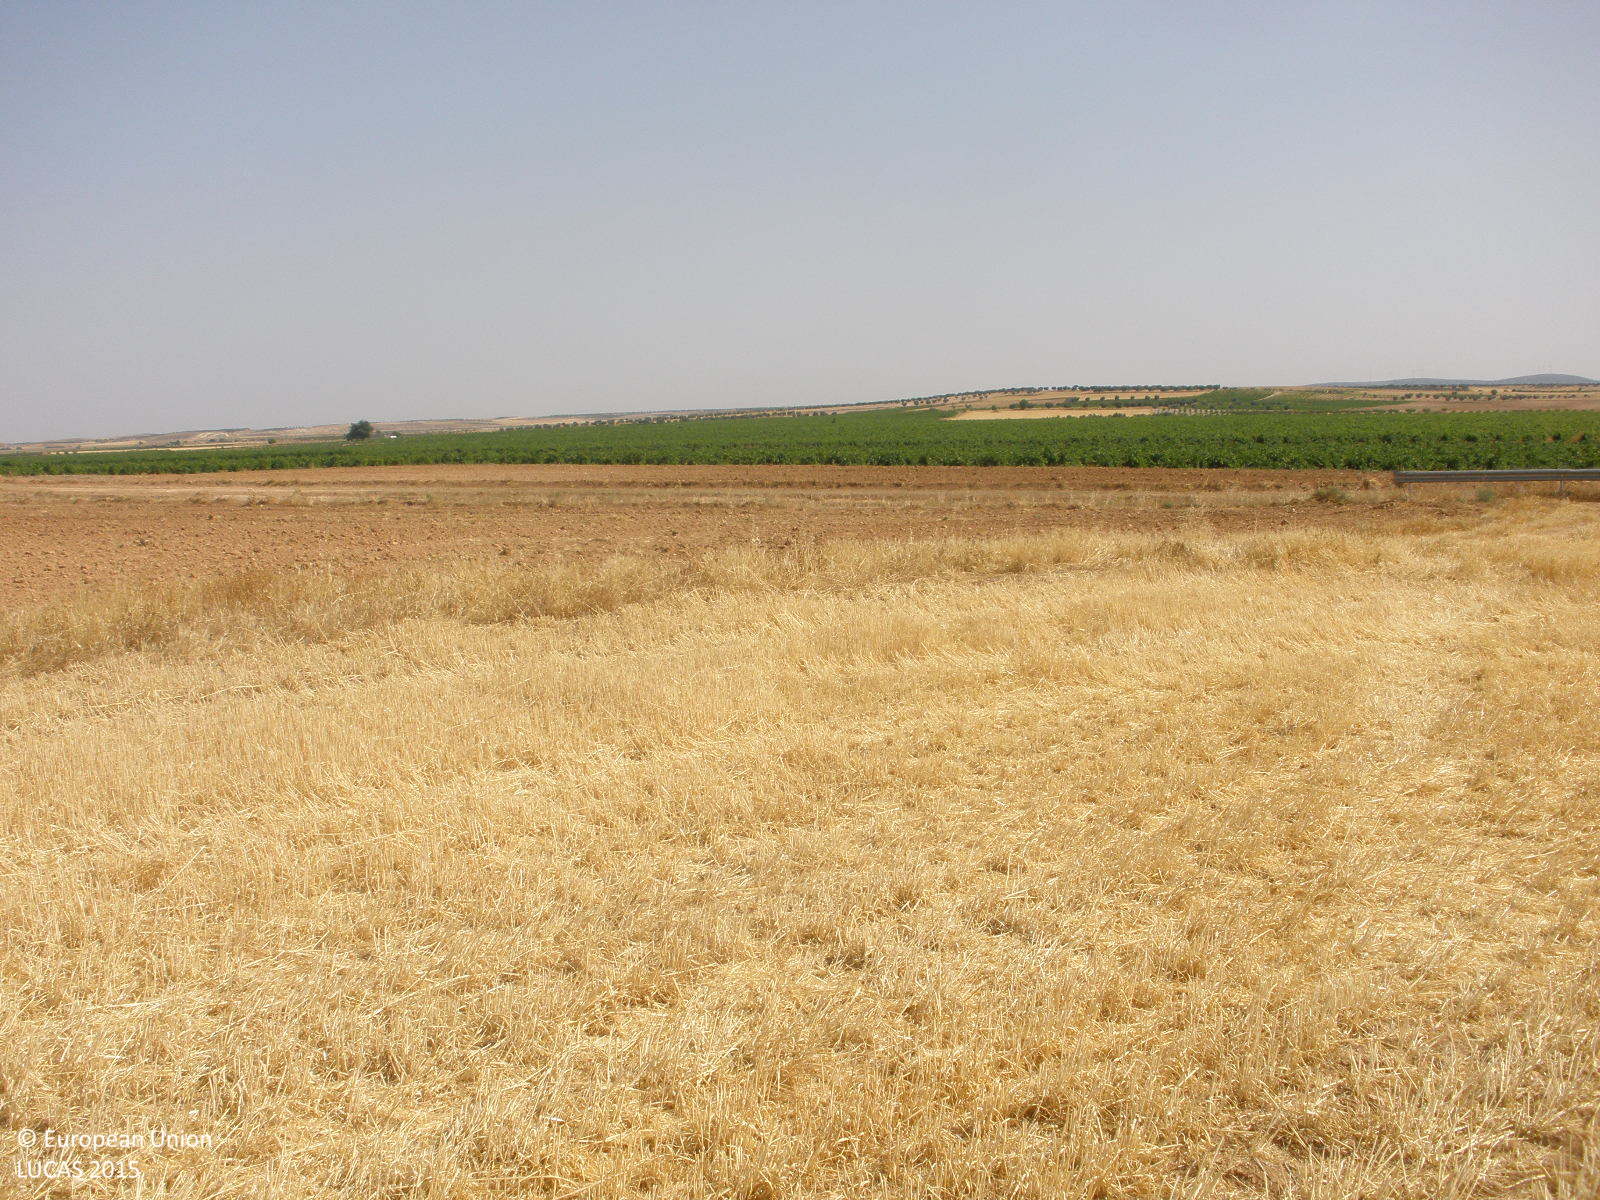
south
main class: Cropland
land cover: Barley
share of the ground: < 10 %
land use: Agriculture (excluding fallow land and kitchen gardens)
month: July
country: ES
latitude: 39.7367
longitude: -3.3379
